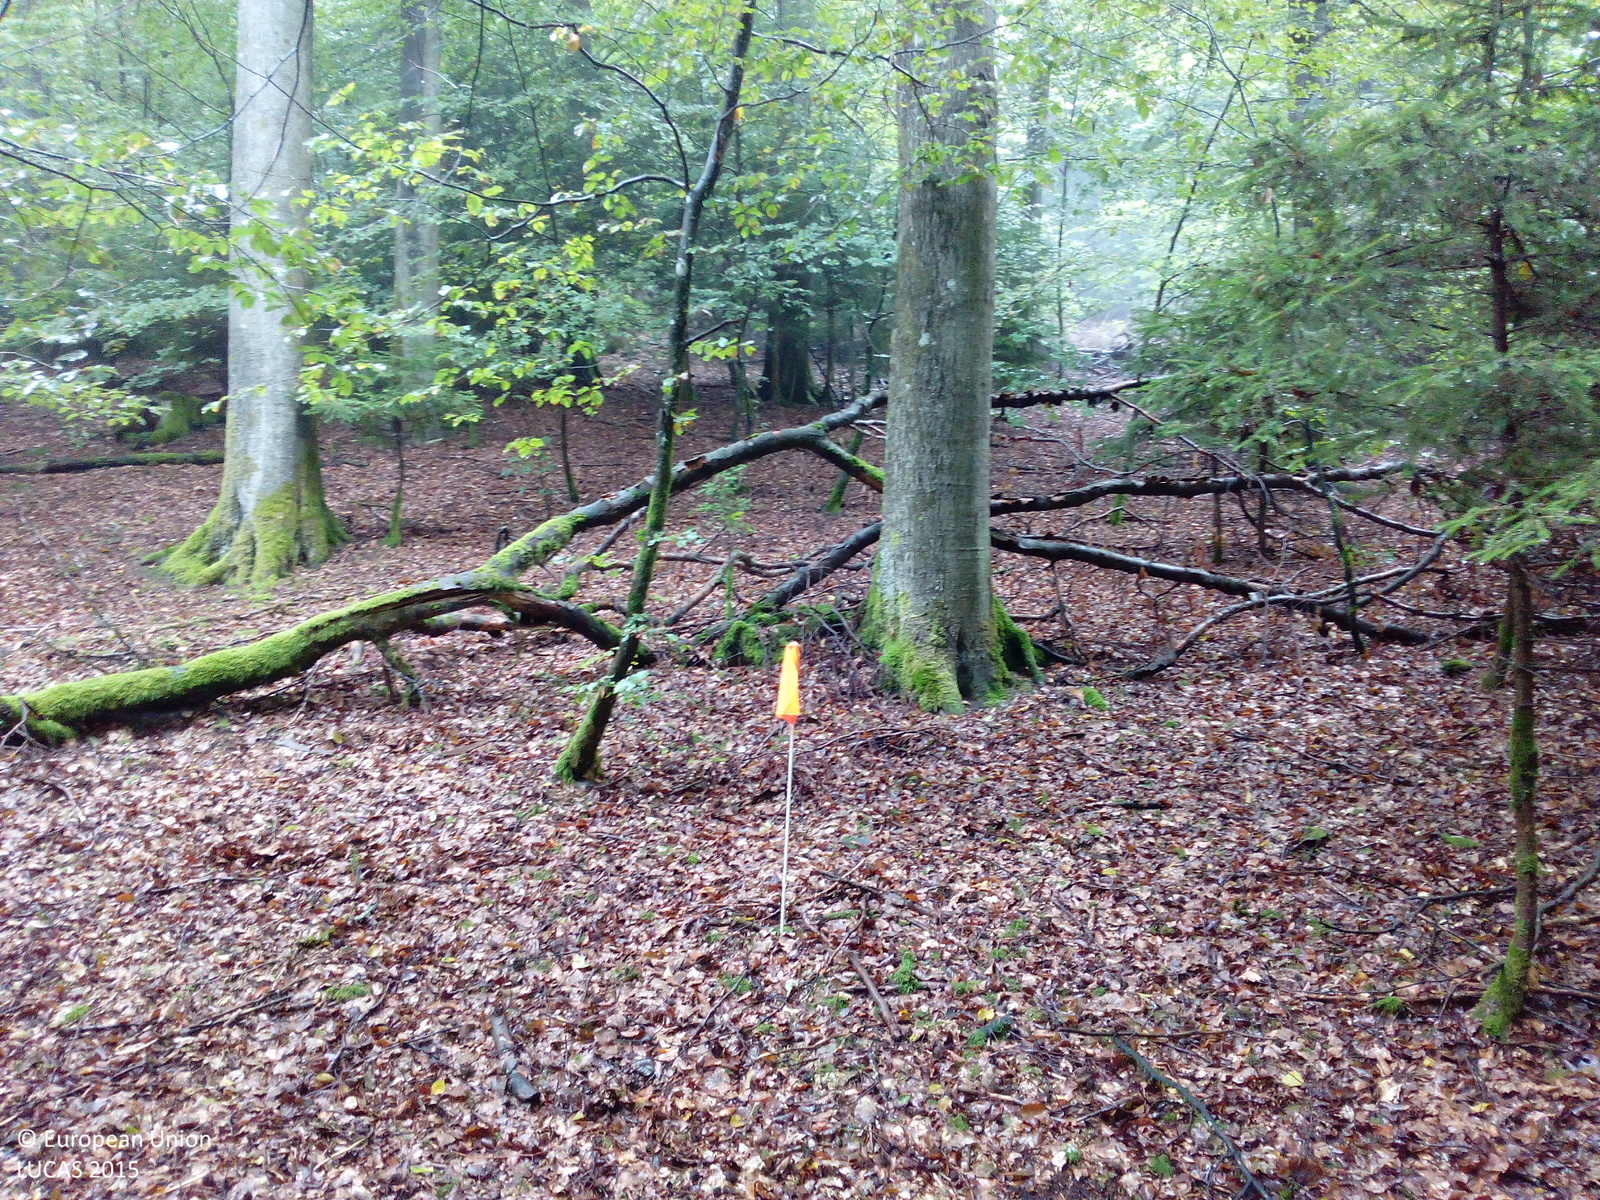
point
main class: Woodland
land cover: Broadleaved woodland
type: beech forest
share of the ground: > 75 %
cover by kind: broadleaved forest trees 80 %, unconsolidated bare surface 15 %, coniferous forest trees 5 %
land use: Forestry
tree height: > 5 m
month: September
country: DE
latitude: 50.0028
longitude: 9.4003
